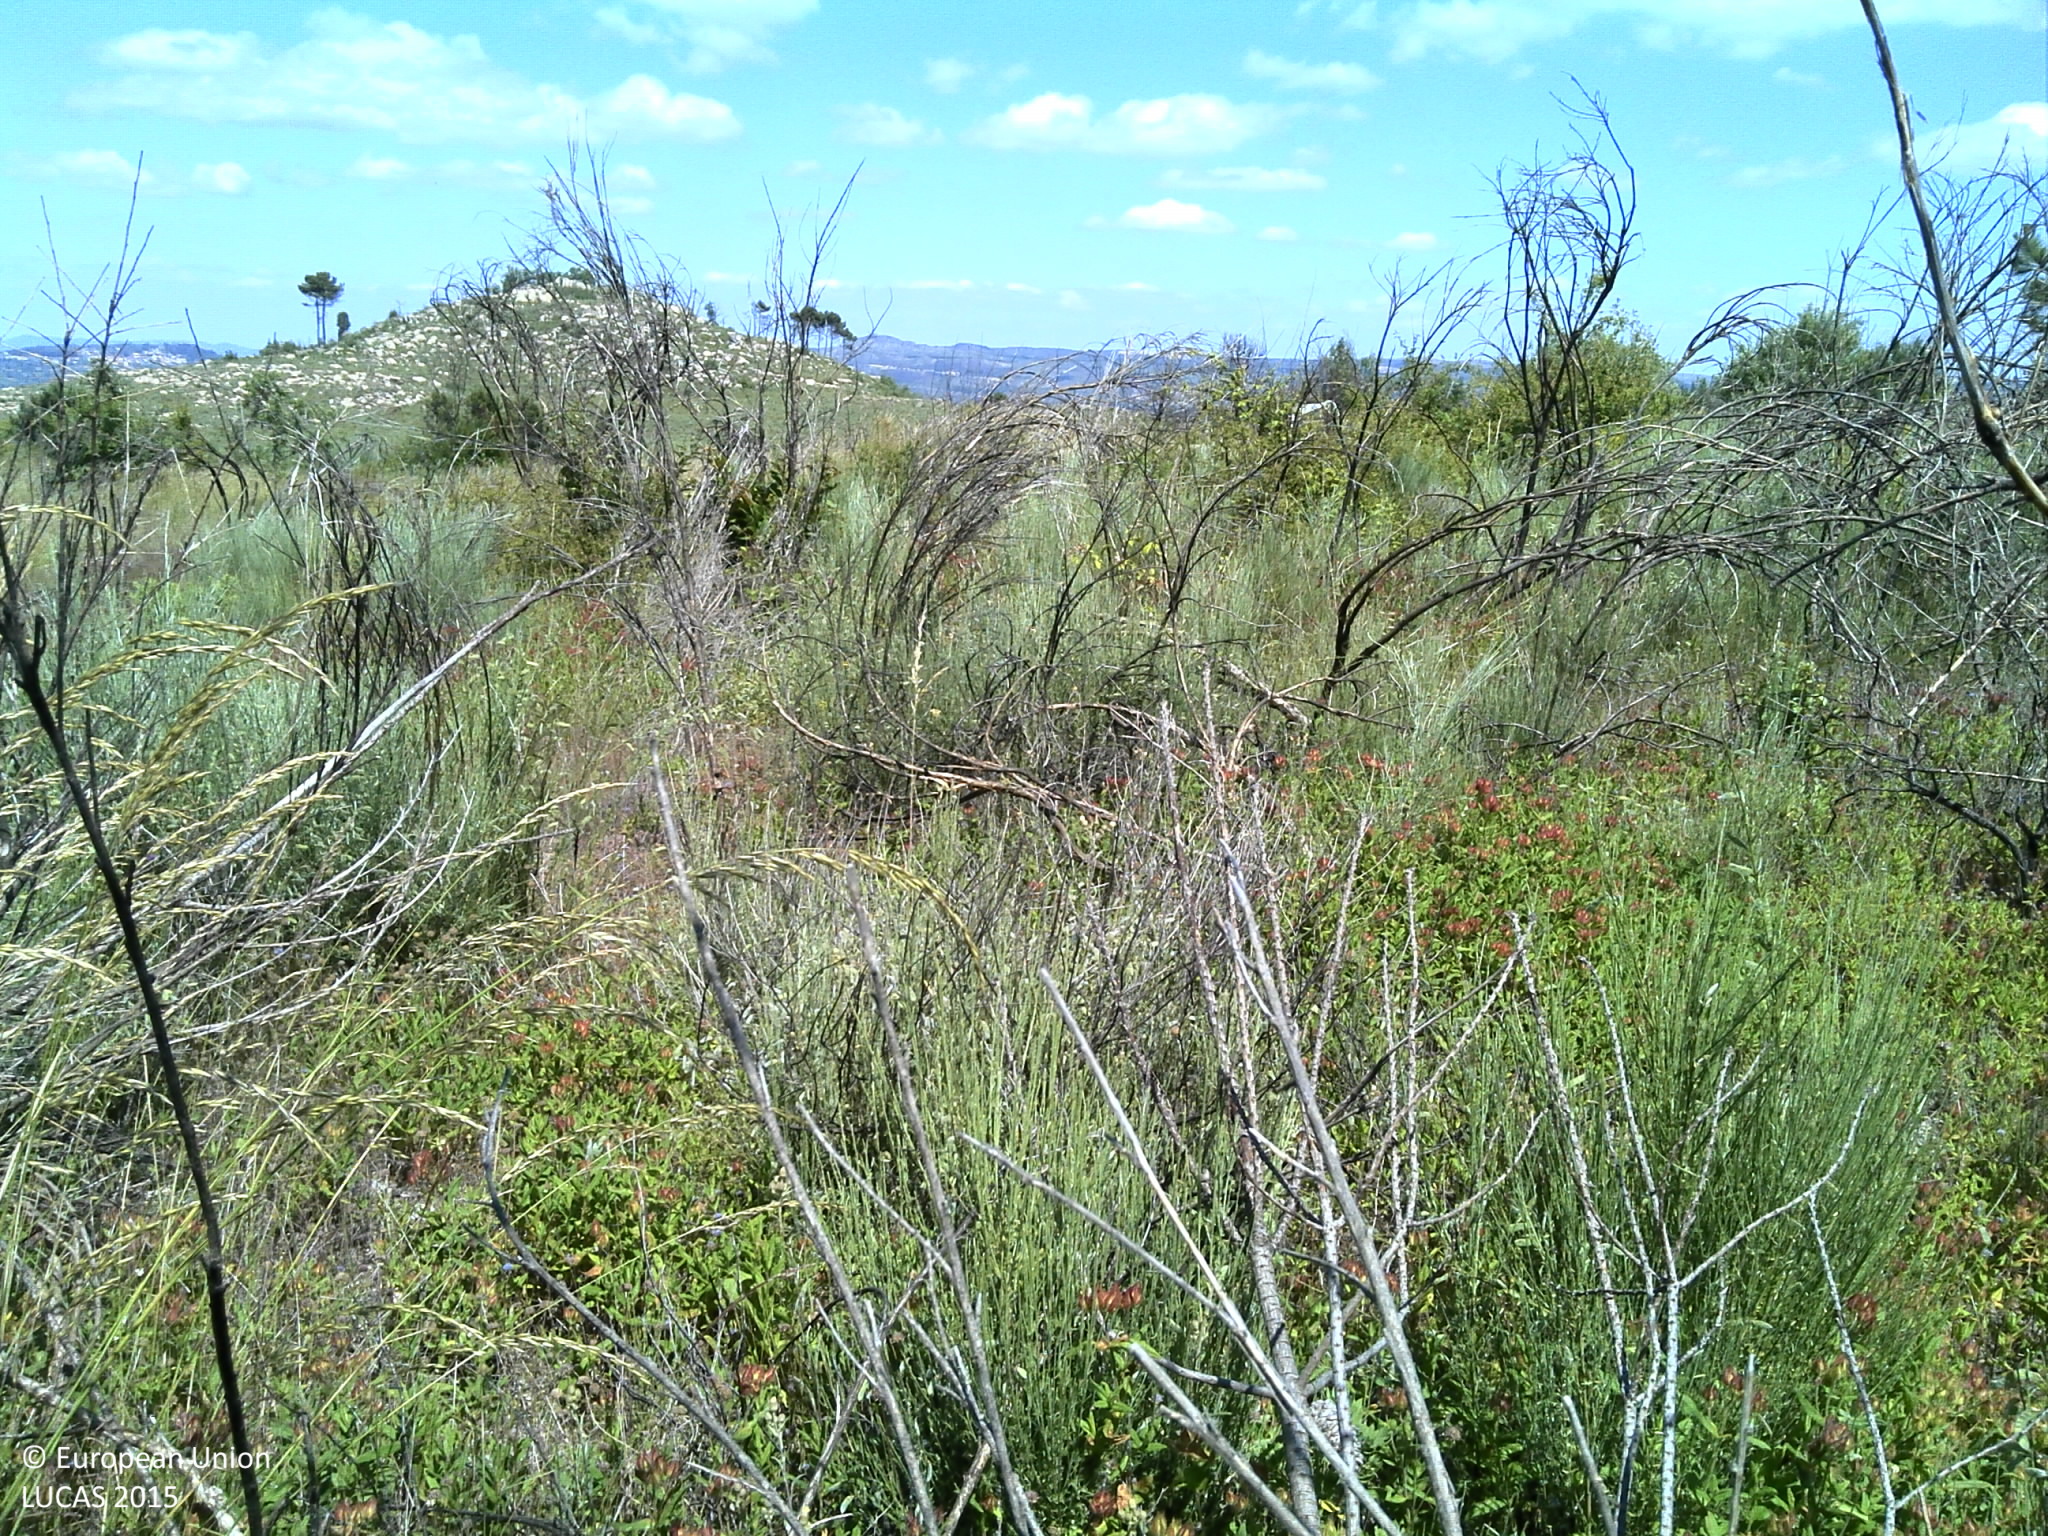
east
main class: Shrubland
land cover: Shrubland with sparse tree cover
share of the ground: 25 - 50 %
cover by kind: shrubs 40 %, unconsolidated bare surface 25 %, herbaceous plants 20 %, consolidated bare surface 10 %, broadleaved forest trees 5 %
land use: Forestry
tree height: < 5 m
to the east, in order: Shrubland with sparse tree cover; Shrubland without tree cover; Grassland without tree/shrub cover; Grass margins; Tracks; Grass margins; Shrubland with sparse tree cover; Shrubland without tree cover; Shrubland with sparse tree cover; Grass margins; Paved roads, cycling and walking lanes; Grass margins; Shrubland without tree cover; Rock outcrops; Shrubland without tree cover; Rock outcrops
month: June
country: PT
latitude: 41.0301
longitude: -7.5699
